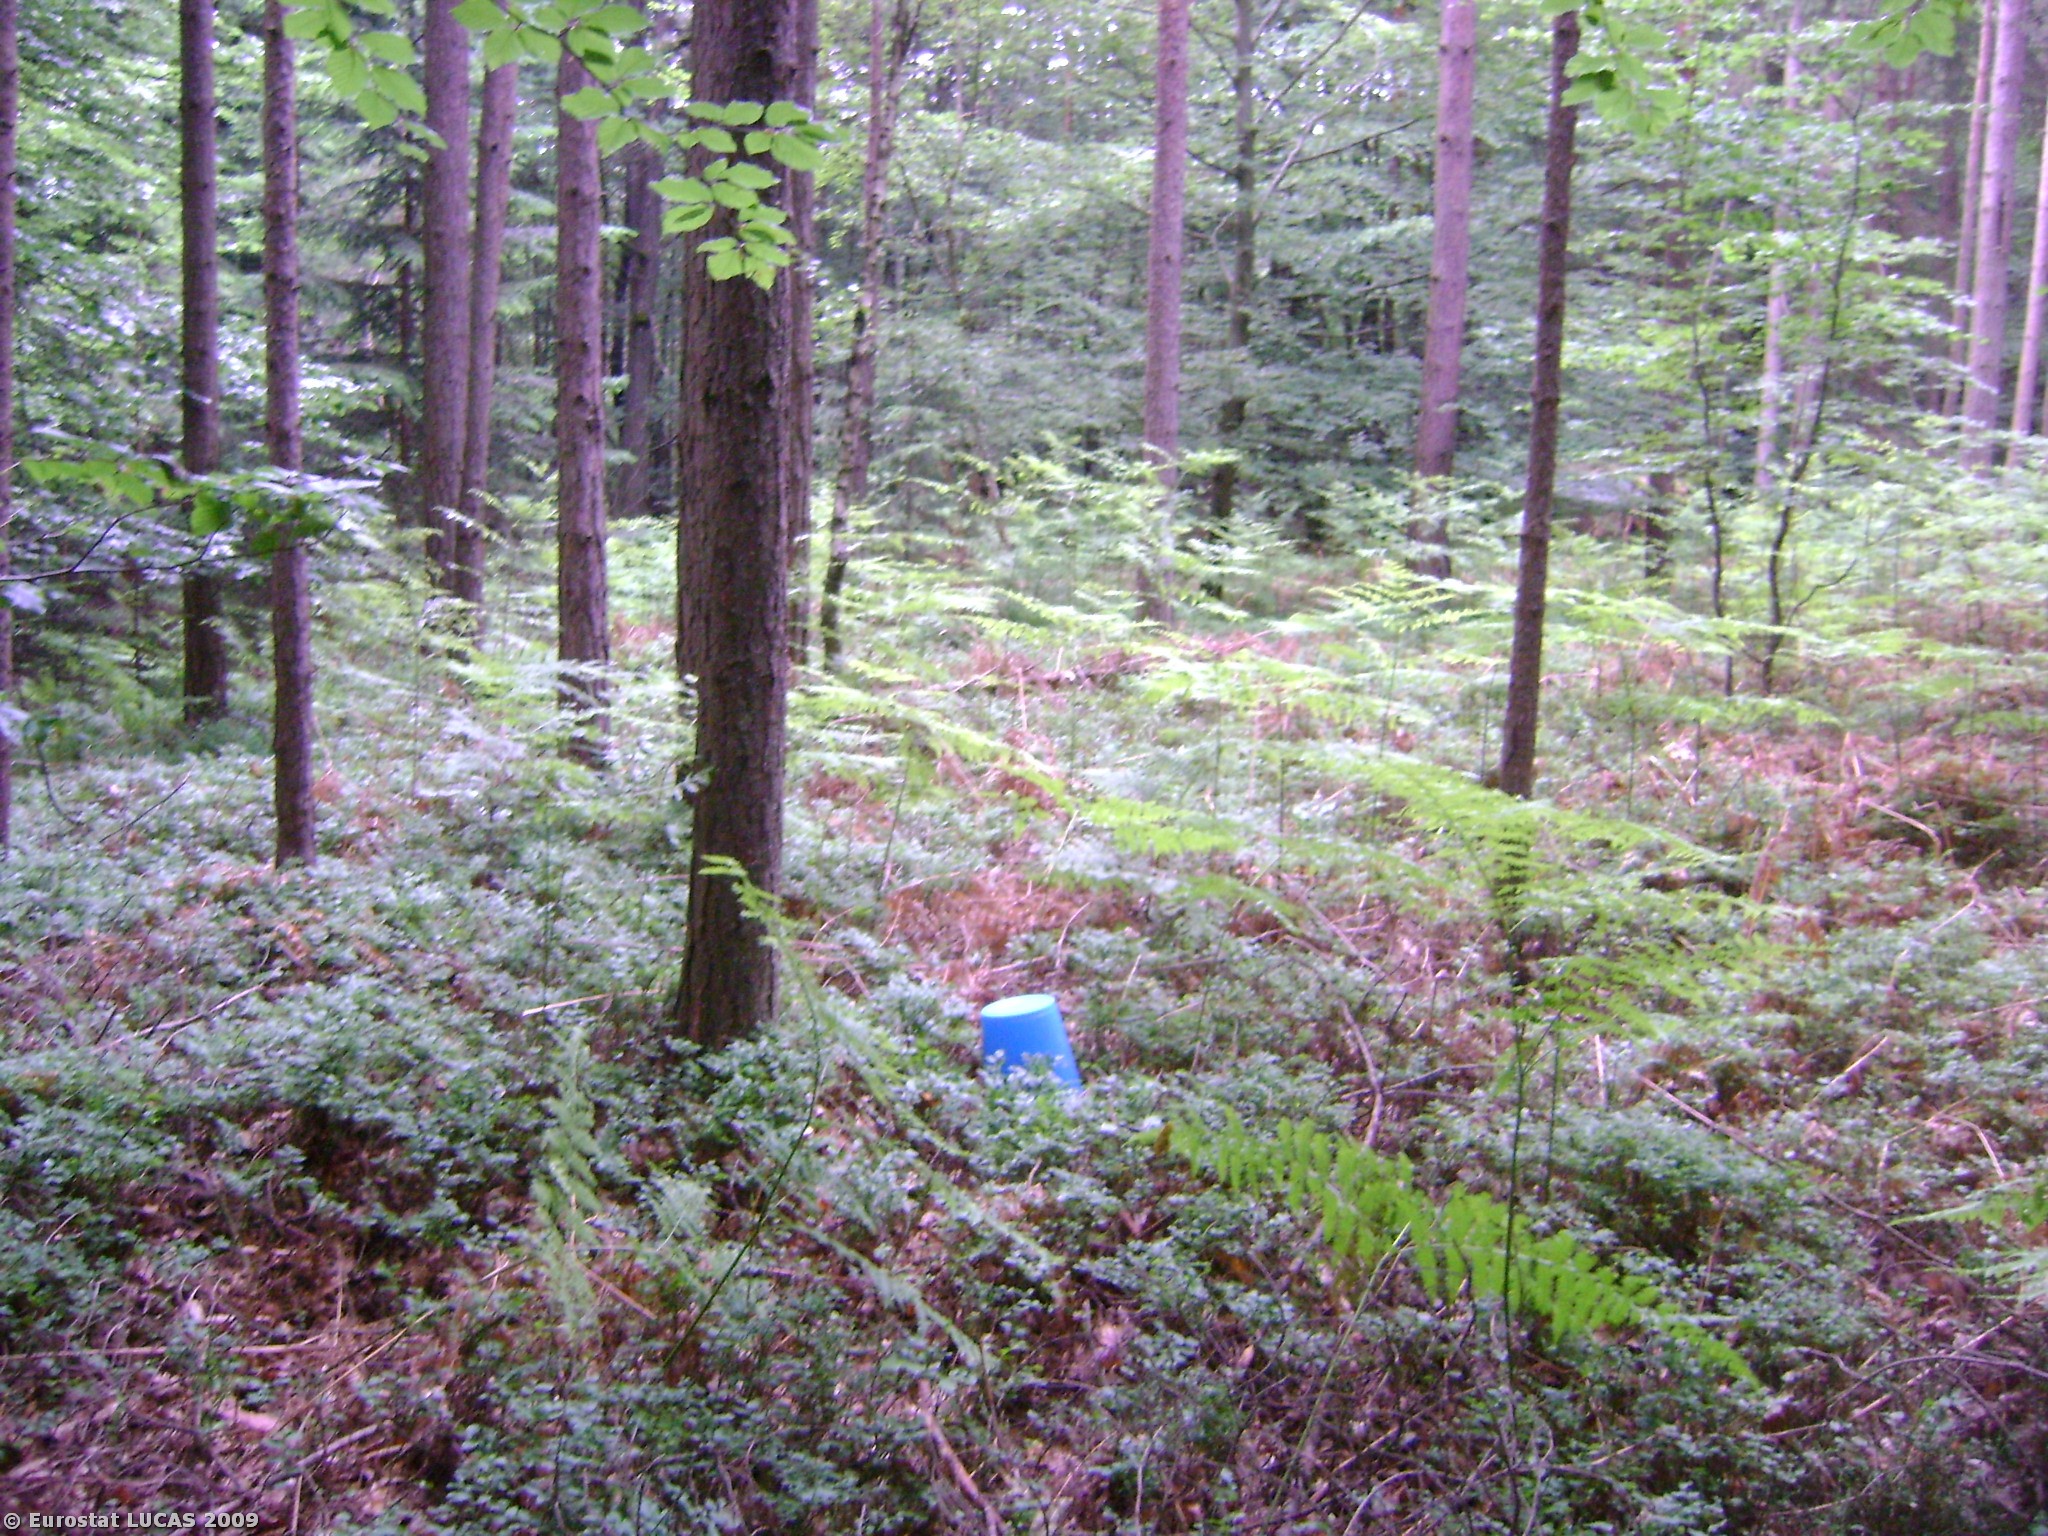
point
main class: Woodland
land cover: Broadleaved woodland
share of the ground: > 75 %
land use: Forestry
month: June
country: AT
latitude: 46.8668
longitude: 15.7066
